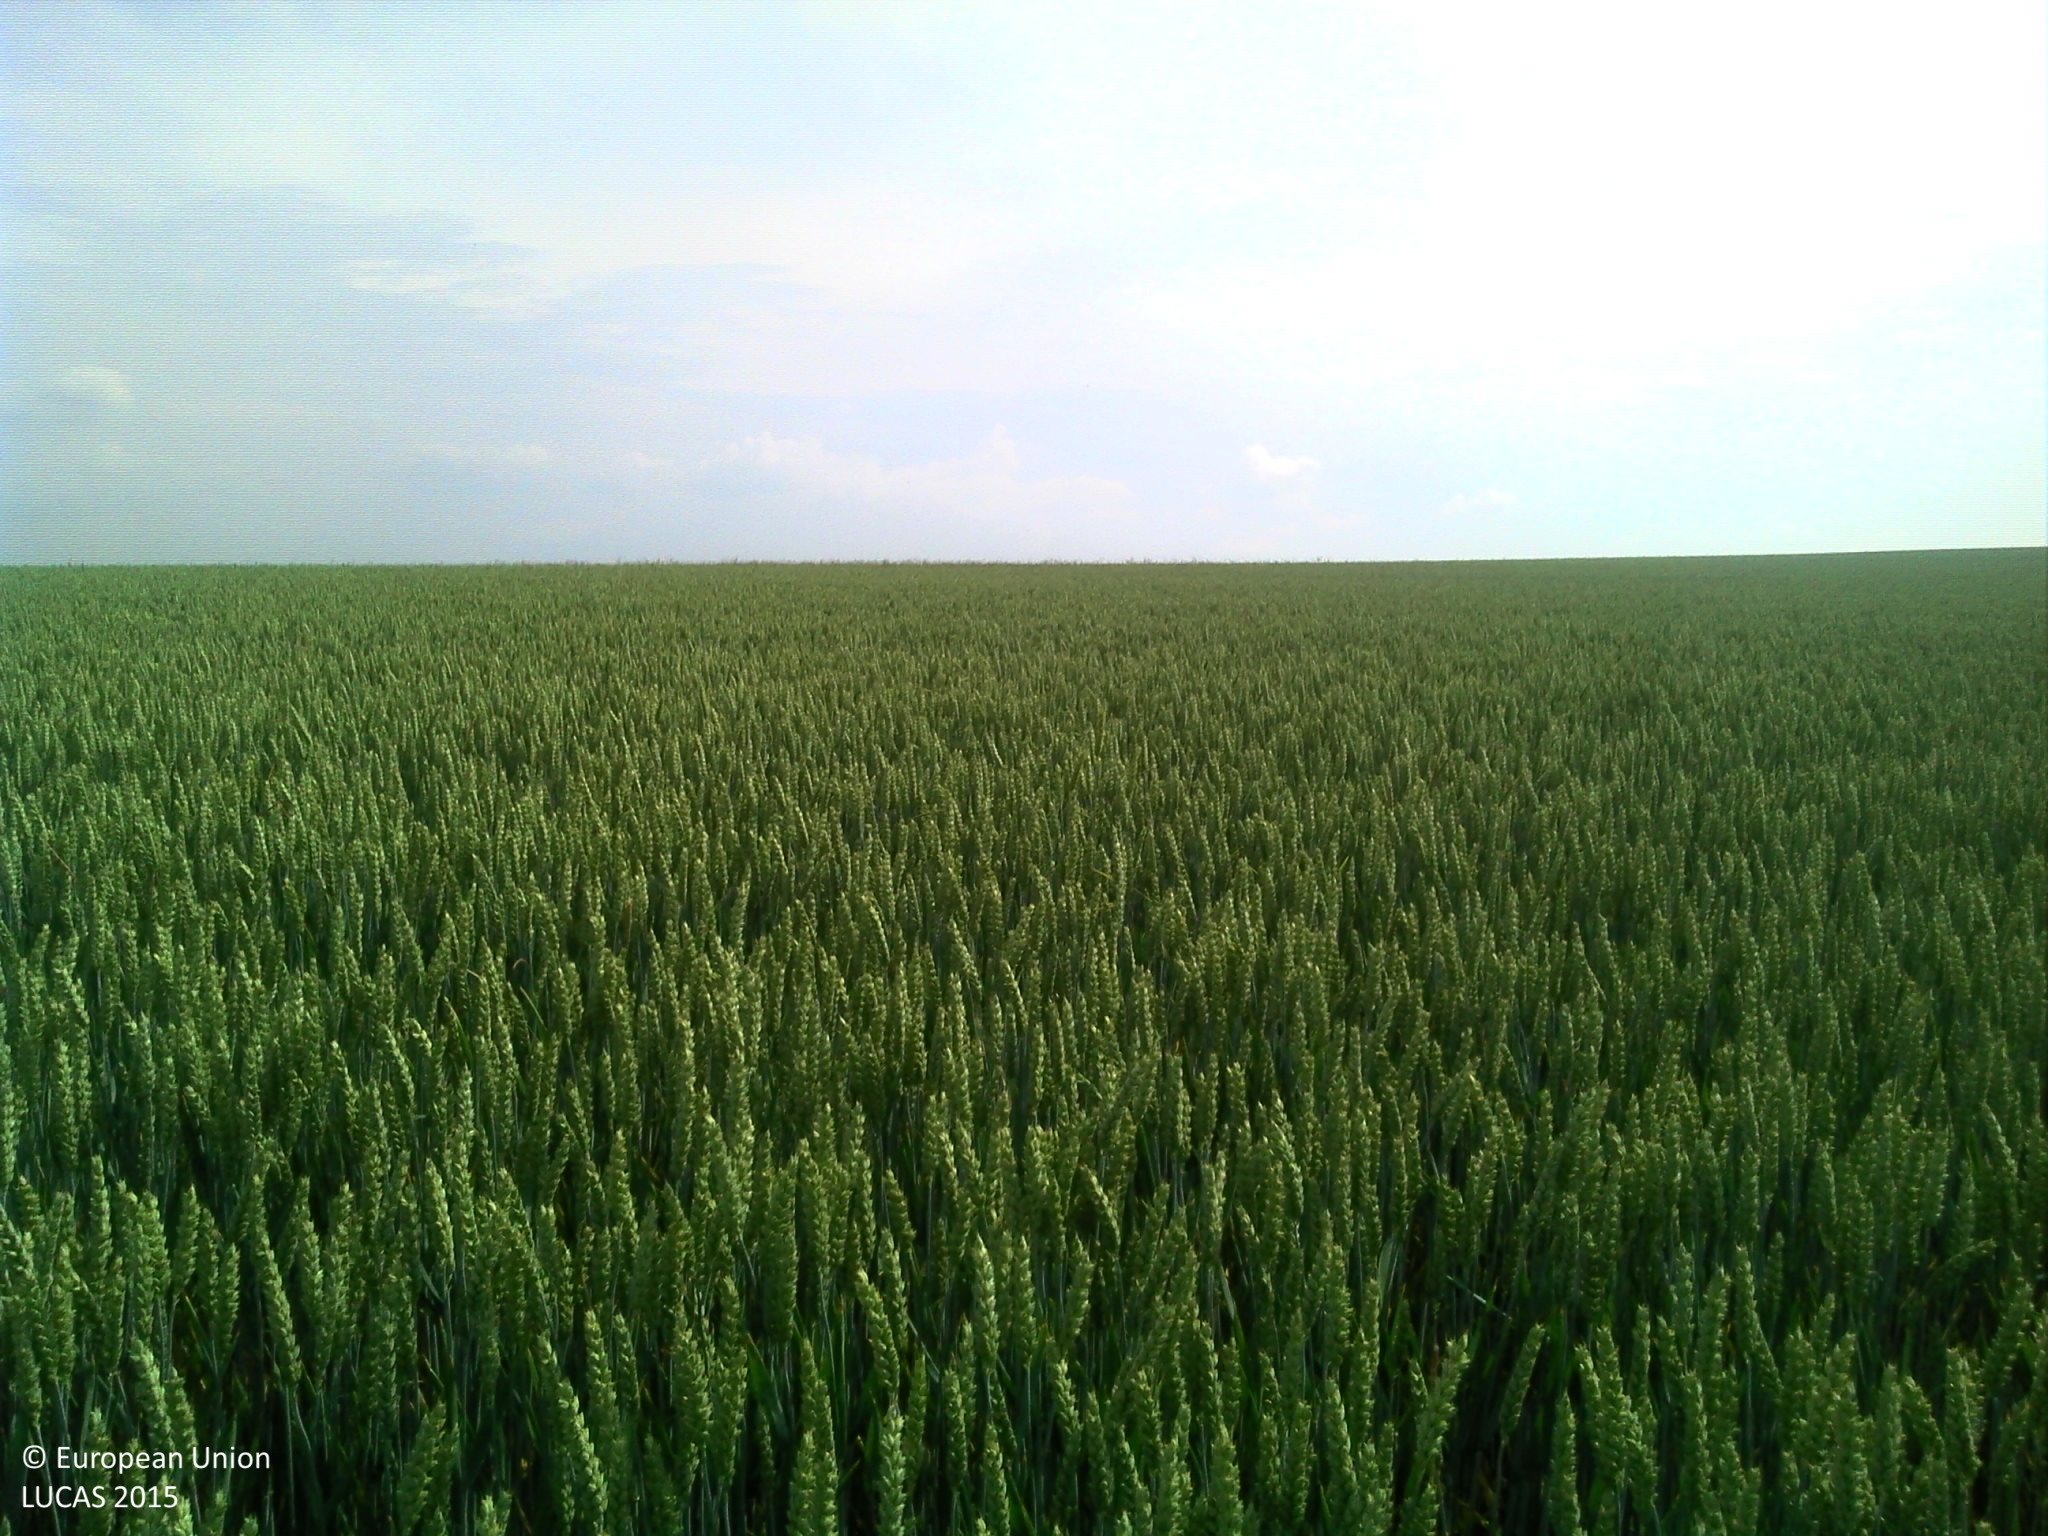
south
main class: Cropland
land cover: Common wheat
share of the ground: > 75 %
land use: Agriculture (excluding fallow land and kitchen gardens)
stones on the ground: 10 - 25 %
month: June
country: FR
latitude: 48.3058
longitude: 4.9427
